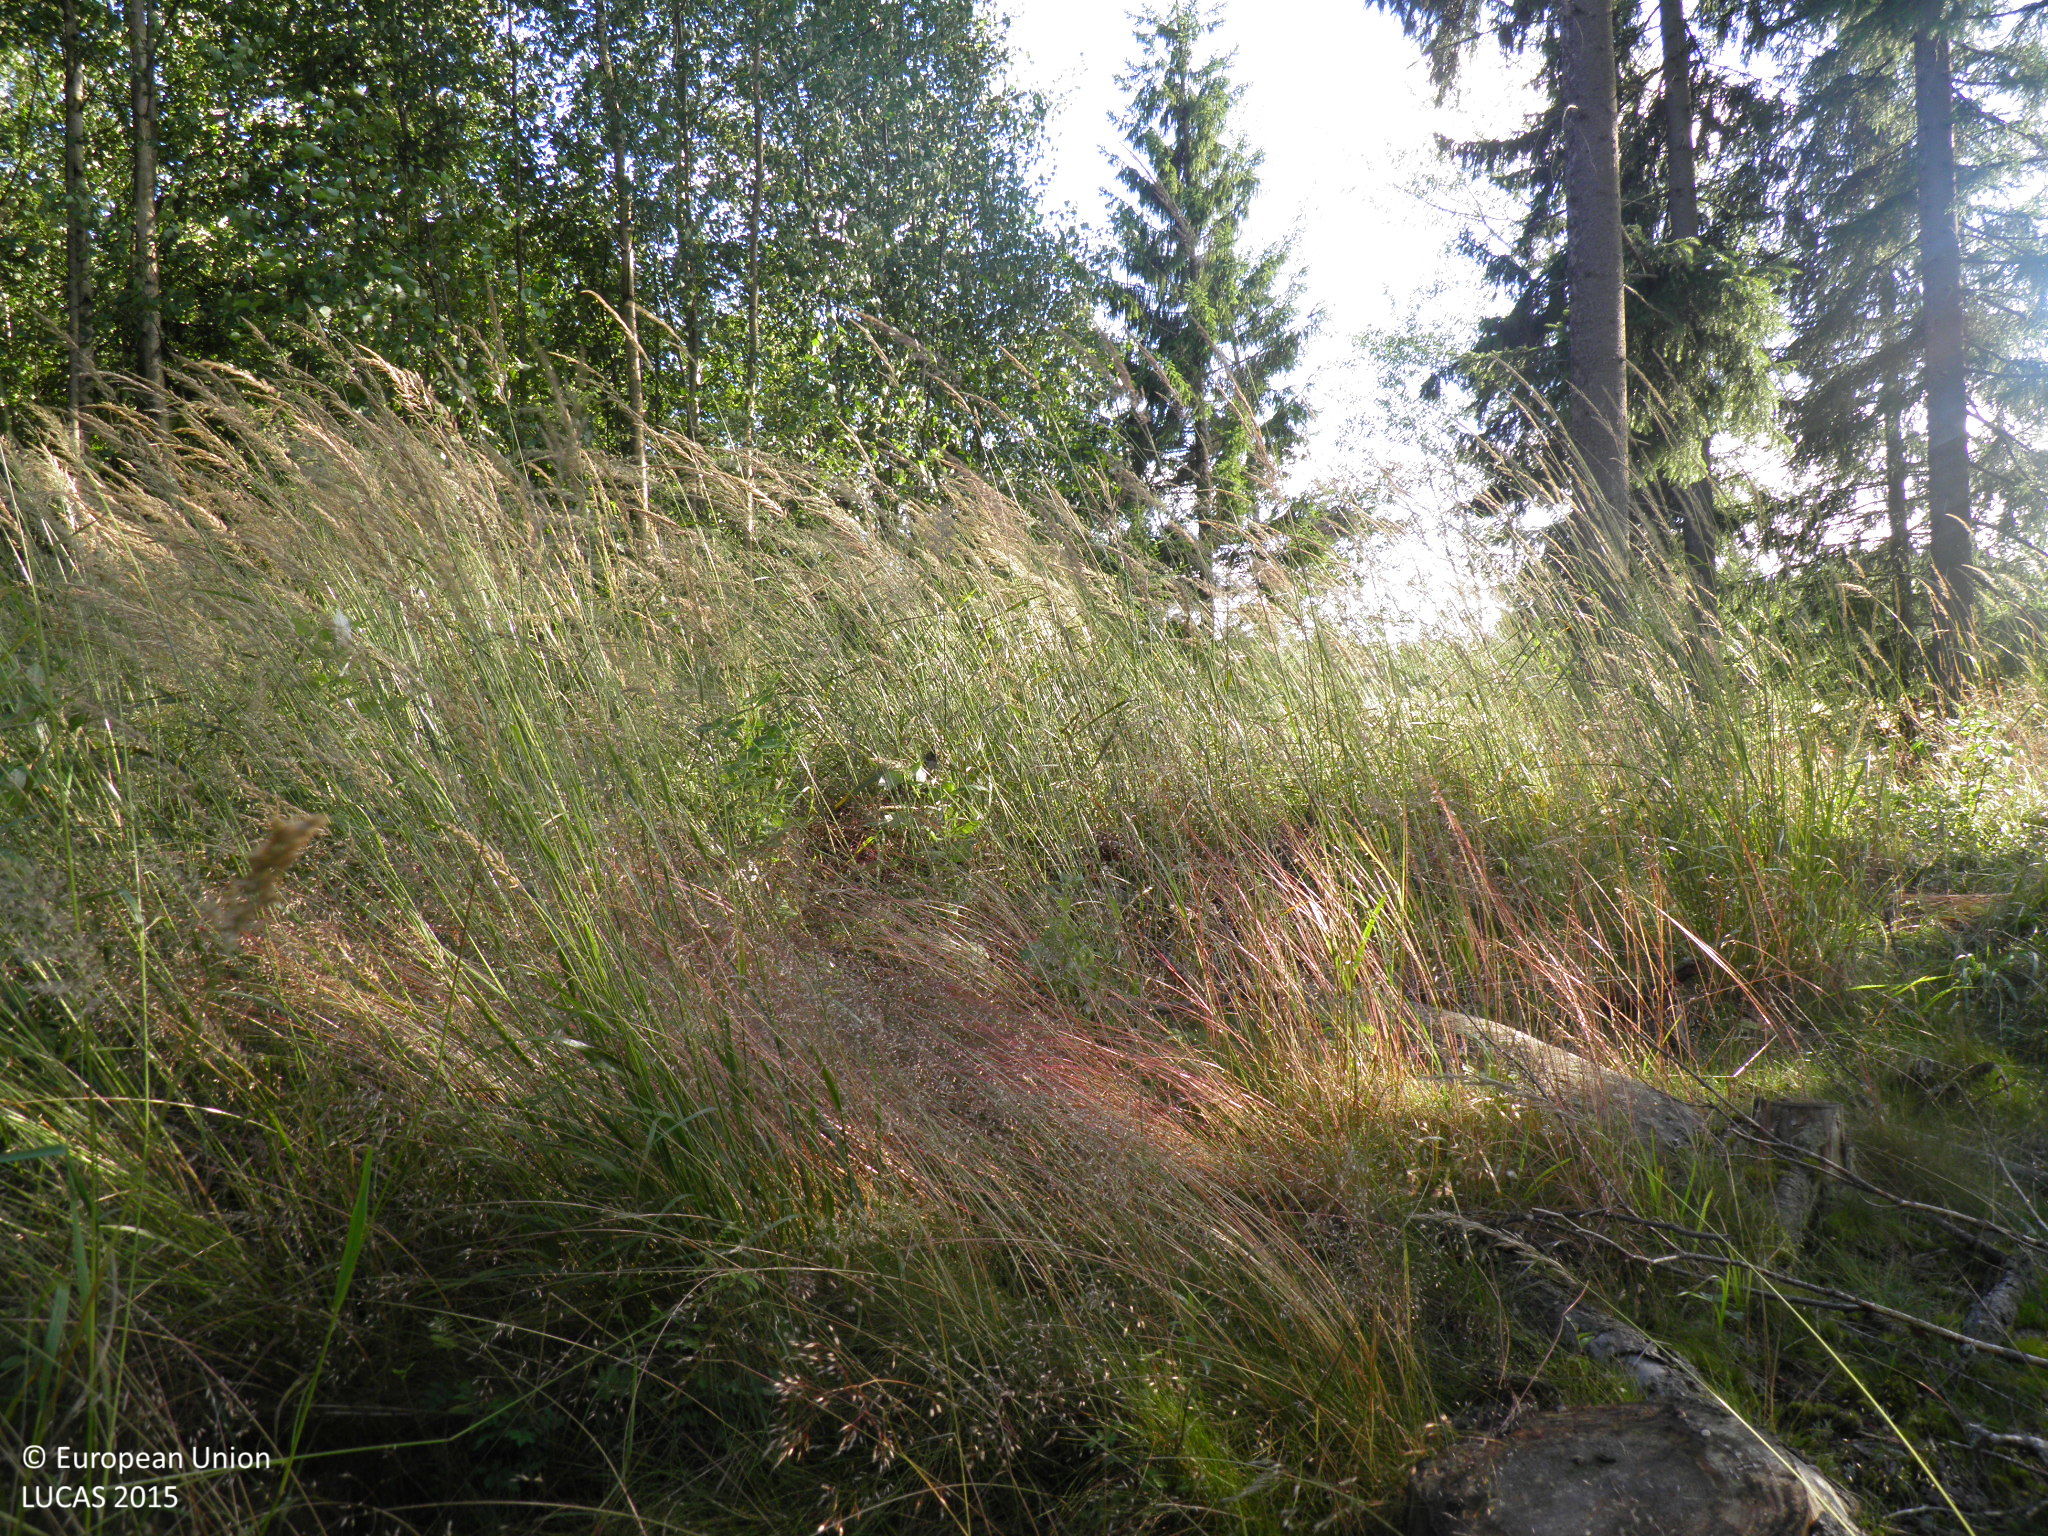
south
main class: Woodland
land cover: Spruce dominated coniferous woodland
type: hemiboreal forest and nemoral coniferous forest and mixed broadleaved-coniferous forest
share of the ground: 25 - 50 %
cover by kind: coniferous forest trees 30 %, herbaceous plants 30 %, shrubs 20 %, broadleaved forest trees 10 %, lichens and mosses 10 %
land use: Forestry
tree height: > 5 m
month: August
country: FI
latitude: 61.0231
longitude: 22.9715
